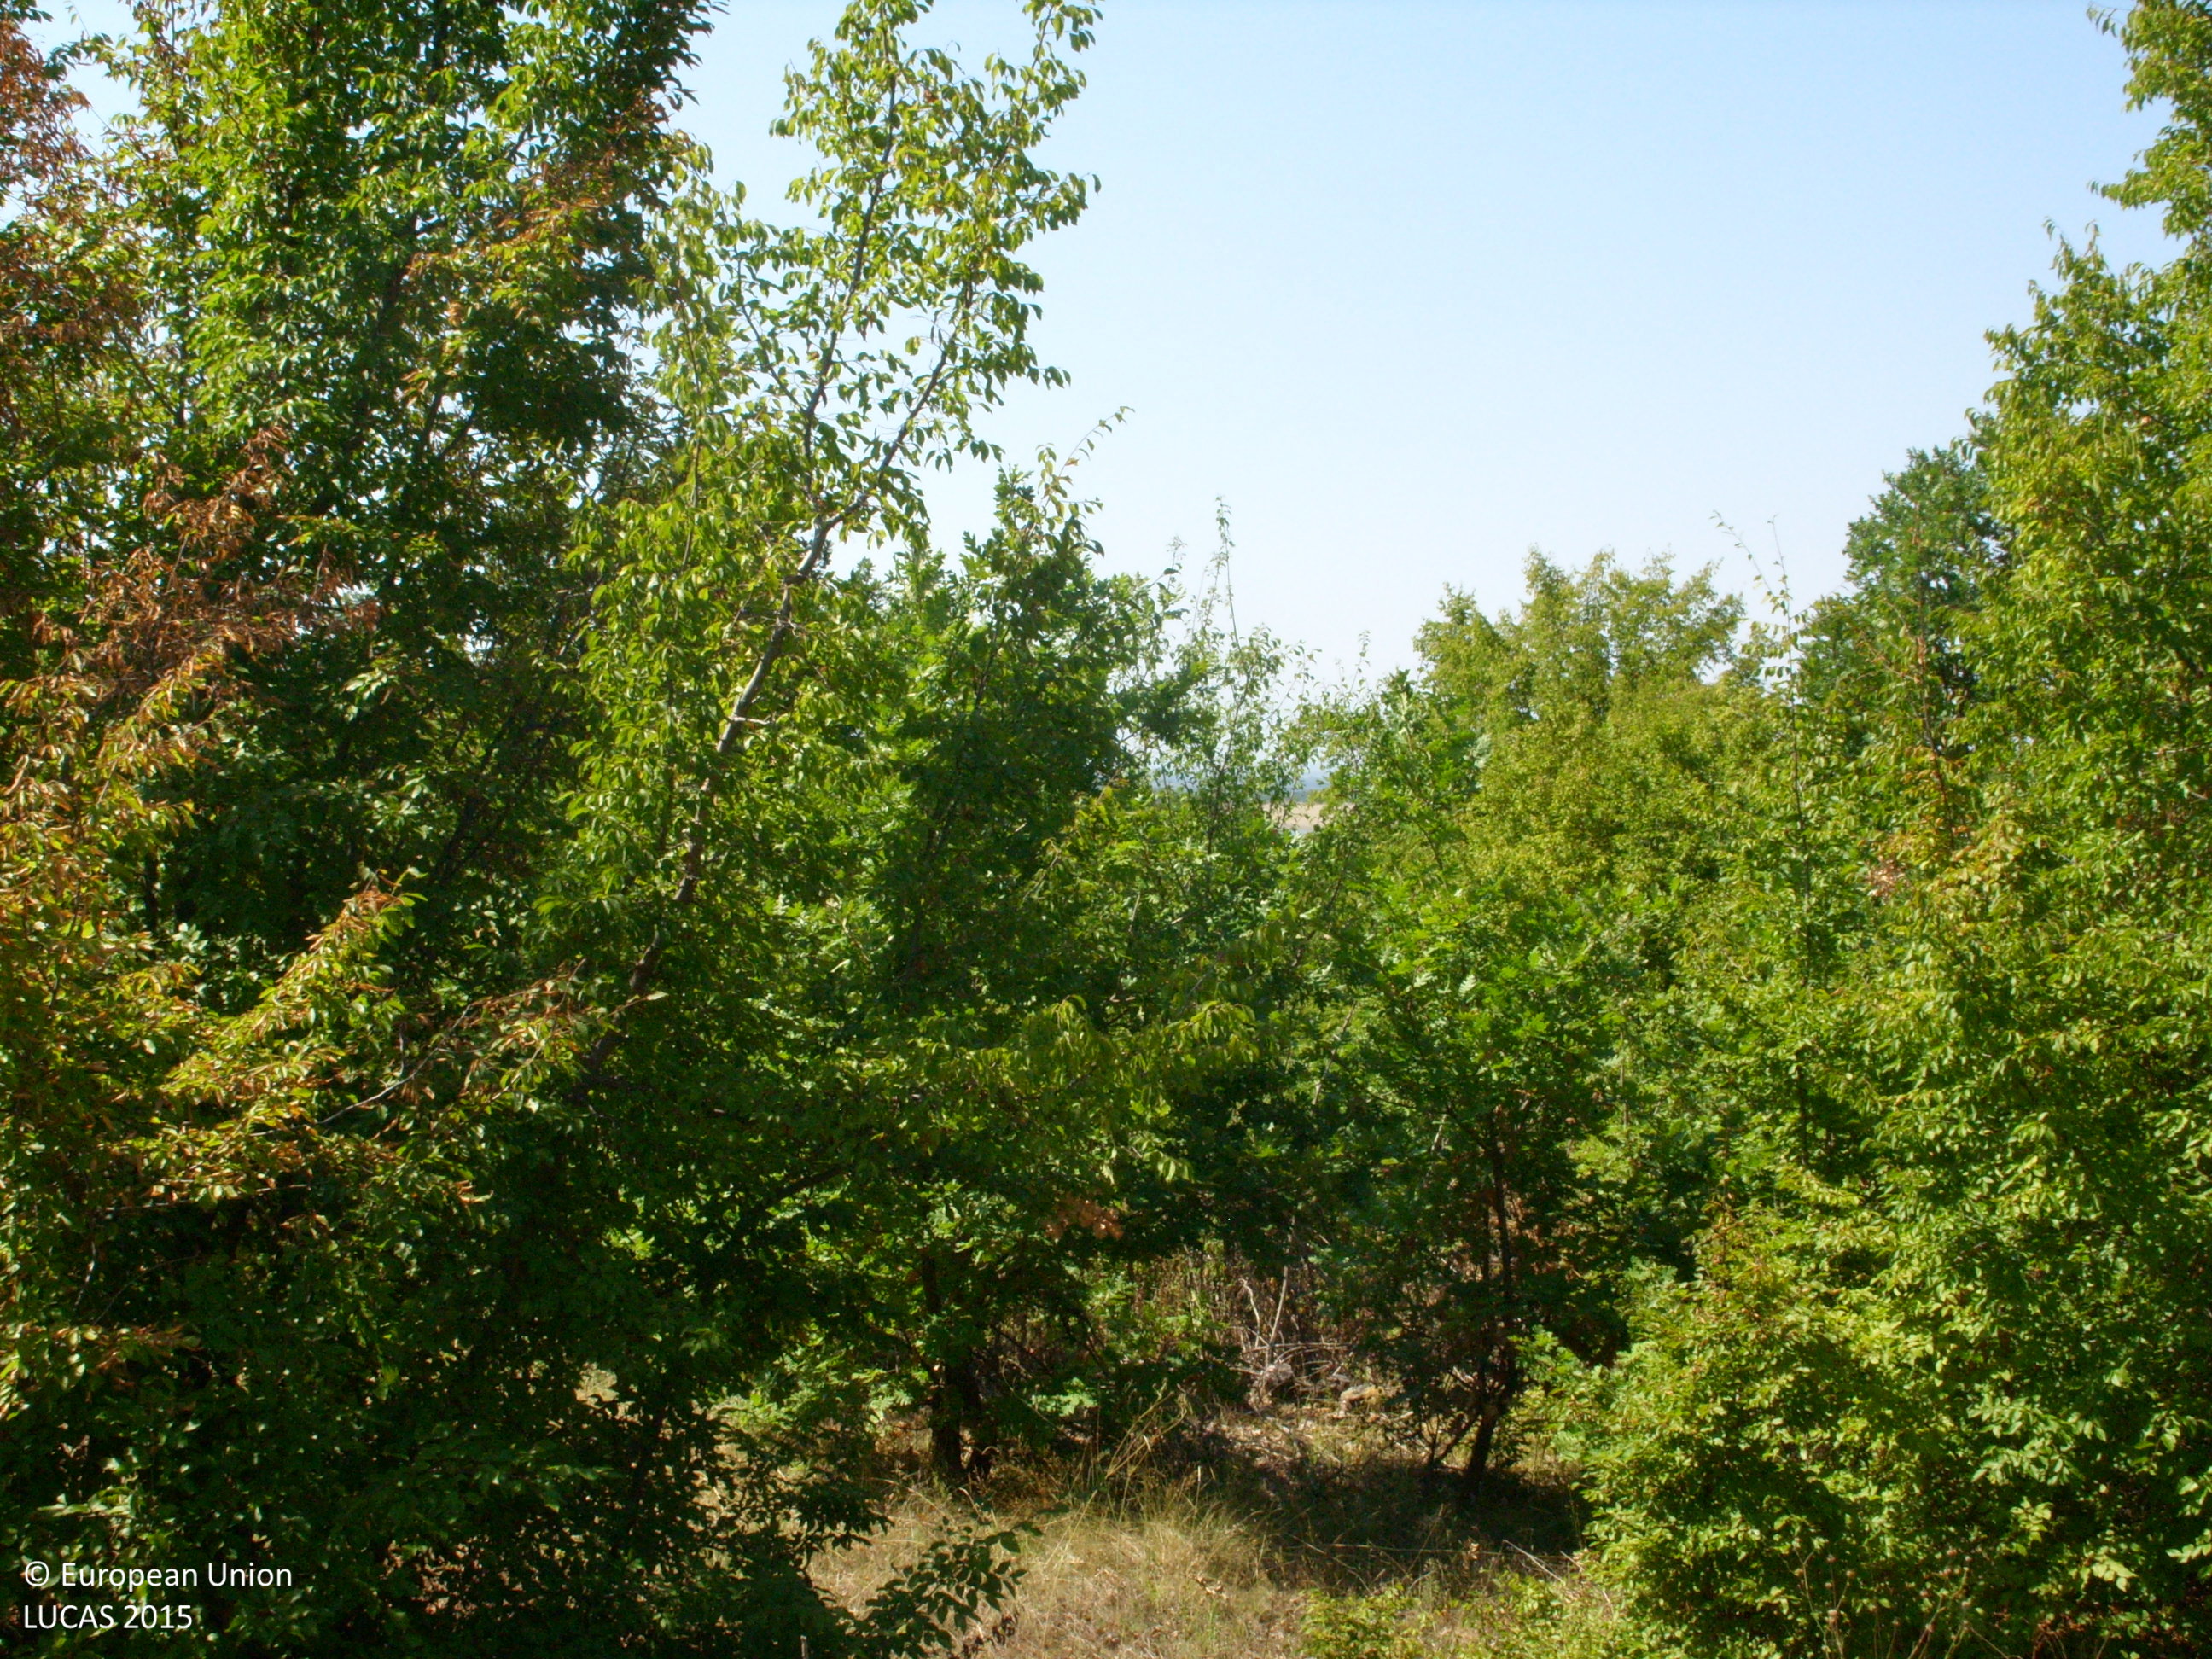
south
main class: Grassland
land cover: Grassland with sparse tree/shrub cover
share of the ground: > 75 %
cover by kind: herbaceous plants 85 %, shrubs 10 %, broadleaved forest trees 5 %
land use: Semi-natural and natural areas not in use
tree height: < 5 m
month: August
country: BG
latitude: 42.4142
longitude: 25.0929
